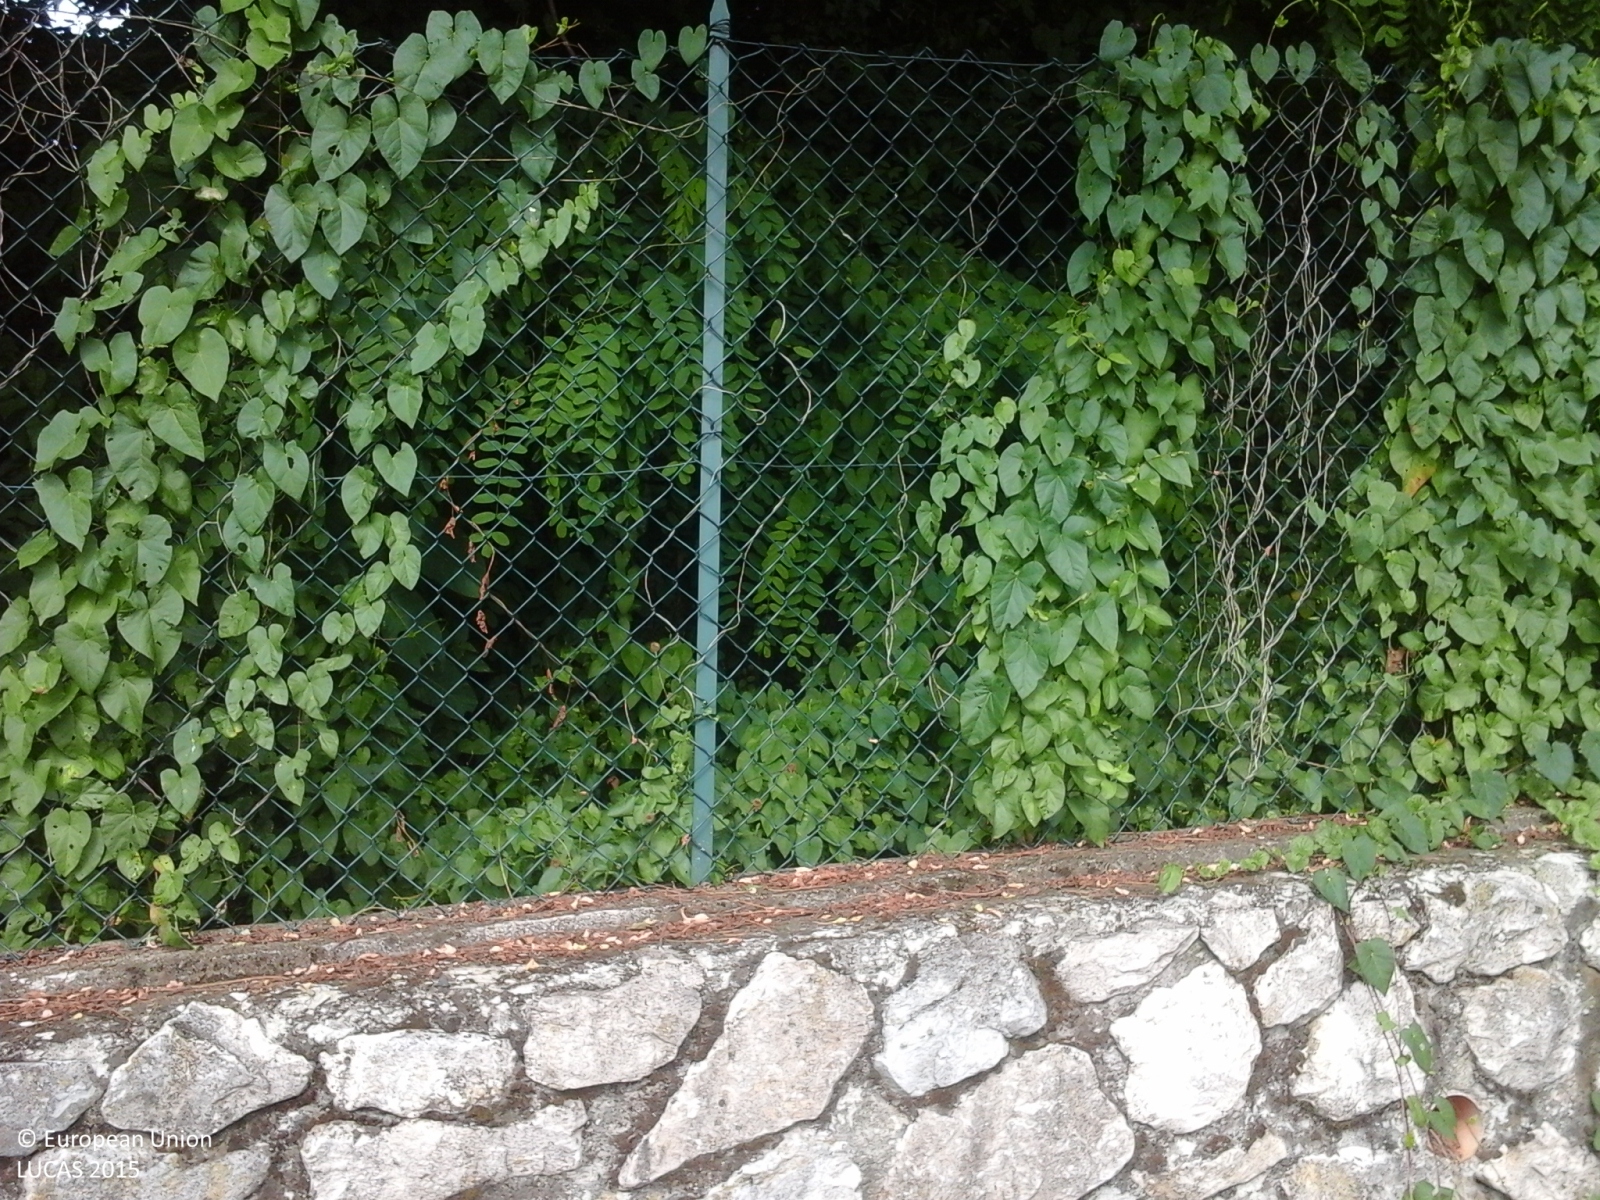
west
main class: Woodland
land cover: Broadleaved woodland
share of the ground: > 75 %
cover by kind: broadleaved forest trees 100 %
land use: Residential
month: June
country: IT
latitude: 45.7097
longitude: 11.5262
